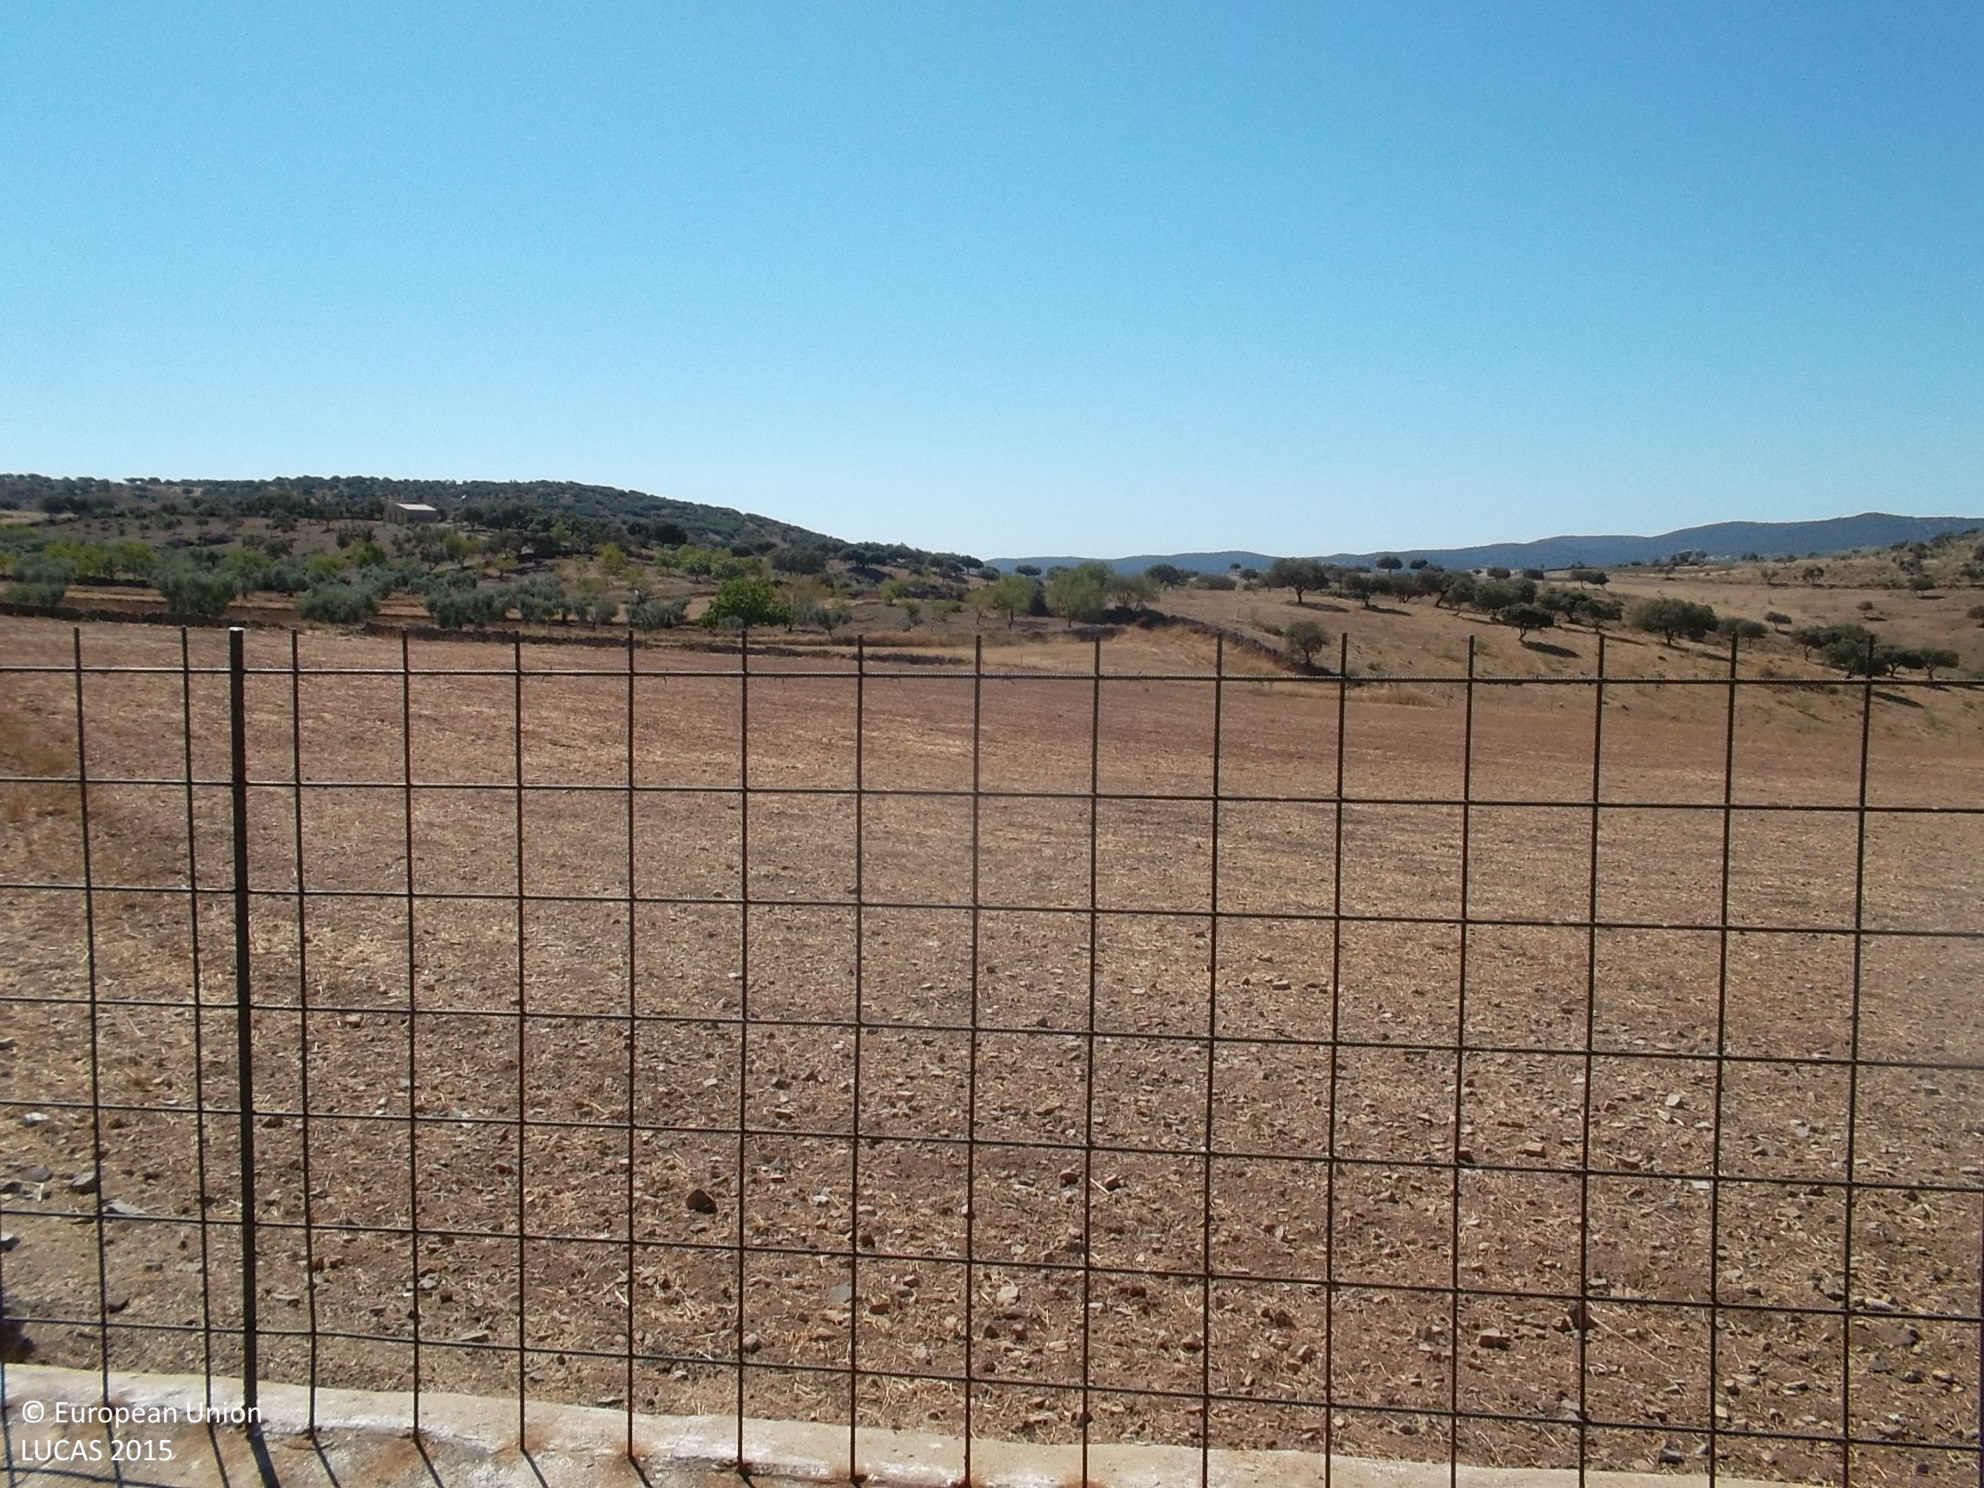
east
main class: Grassland
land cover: Grassland with sparse tree/shrub cover
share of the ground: > 75 %
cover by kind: herbaceous plants 90 %, broadleaved forest trees 5 %, shrubs 5 %
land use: Agriculture (excluding fallow land and kitchen gardens)
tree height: < 5 m
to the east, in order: Grassland with sparse tree/shrub cover; Tracks; Grassland without tree/shrub cover; Grassland with sparse tree/shrub cover; Broadleaved woodland
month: August
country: ES
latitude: 38.5194
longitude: -6.6530
